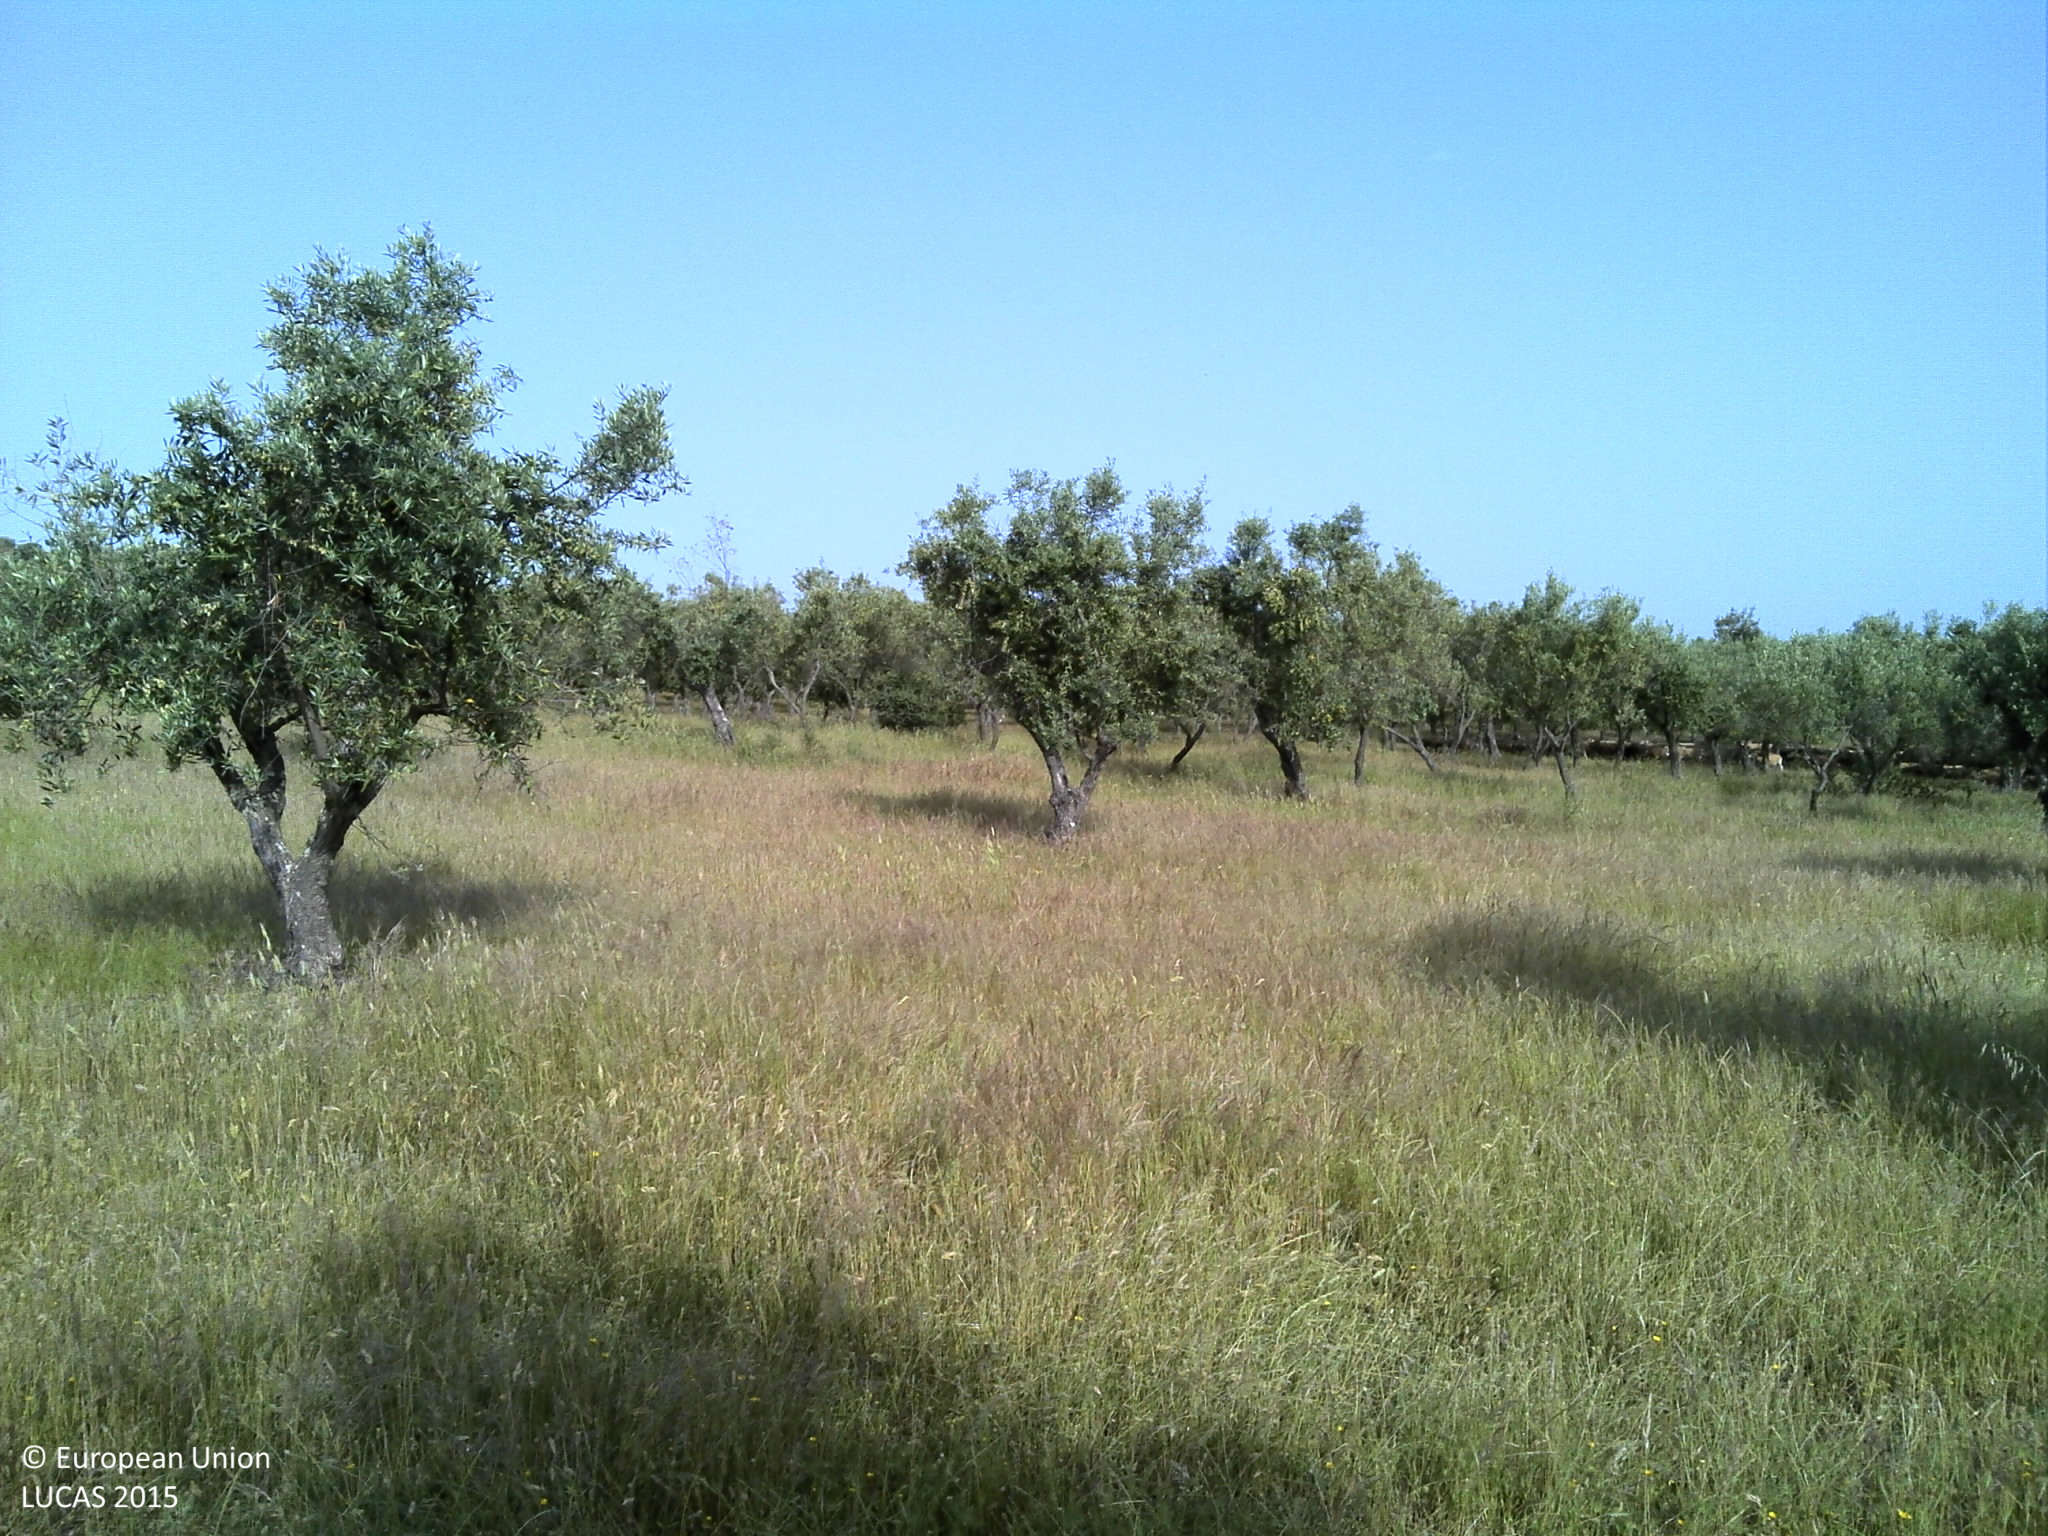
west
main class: Cropland
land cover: Olive groves
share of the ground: 25 - 50 %
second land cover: Grassland without tree/shrub cover
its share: 50 - 75 %
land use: Agriculture (excluding fallow land and kitchen gardens)
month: May
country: PT
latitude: 39.0136
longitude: -7.7958
